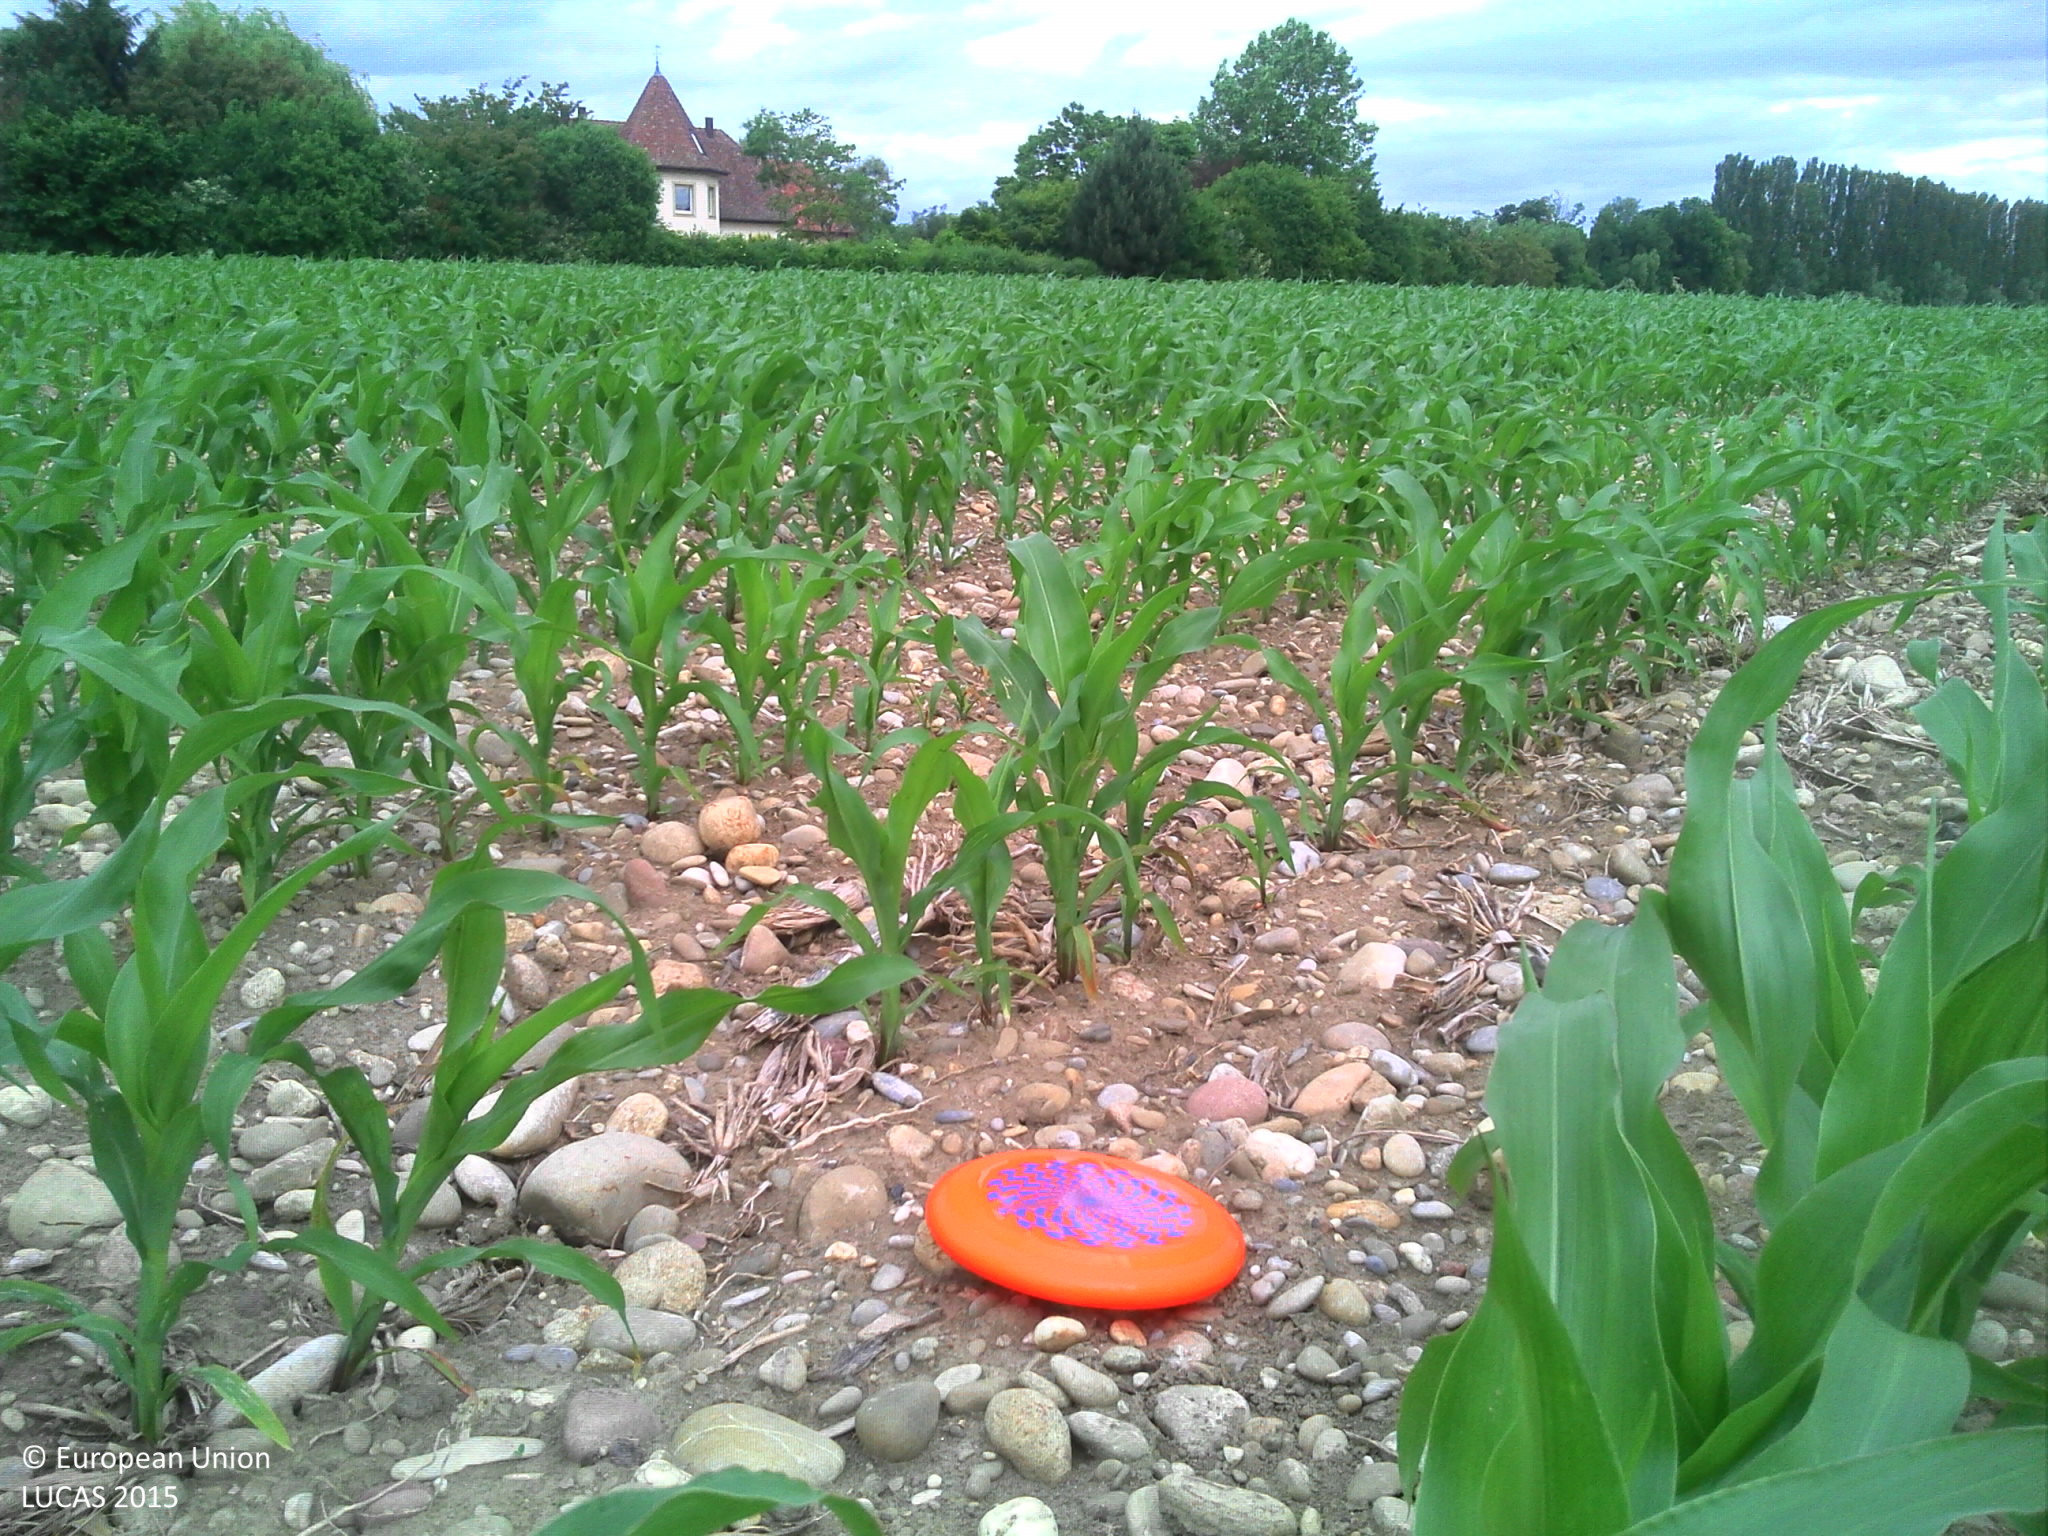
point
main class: Cropland
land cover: Maize
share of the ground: 10 - 25 %
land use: Agriculture (excluding fallow land and kitchen gardens)
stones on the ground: 10 - 25 %
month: June
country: FR
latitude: 47.9443
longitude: 7.5512
